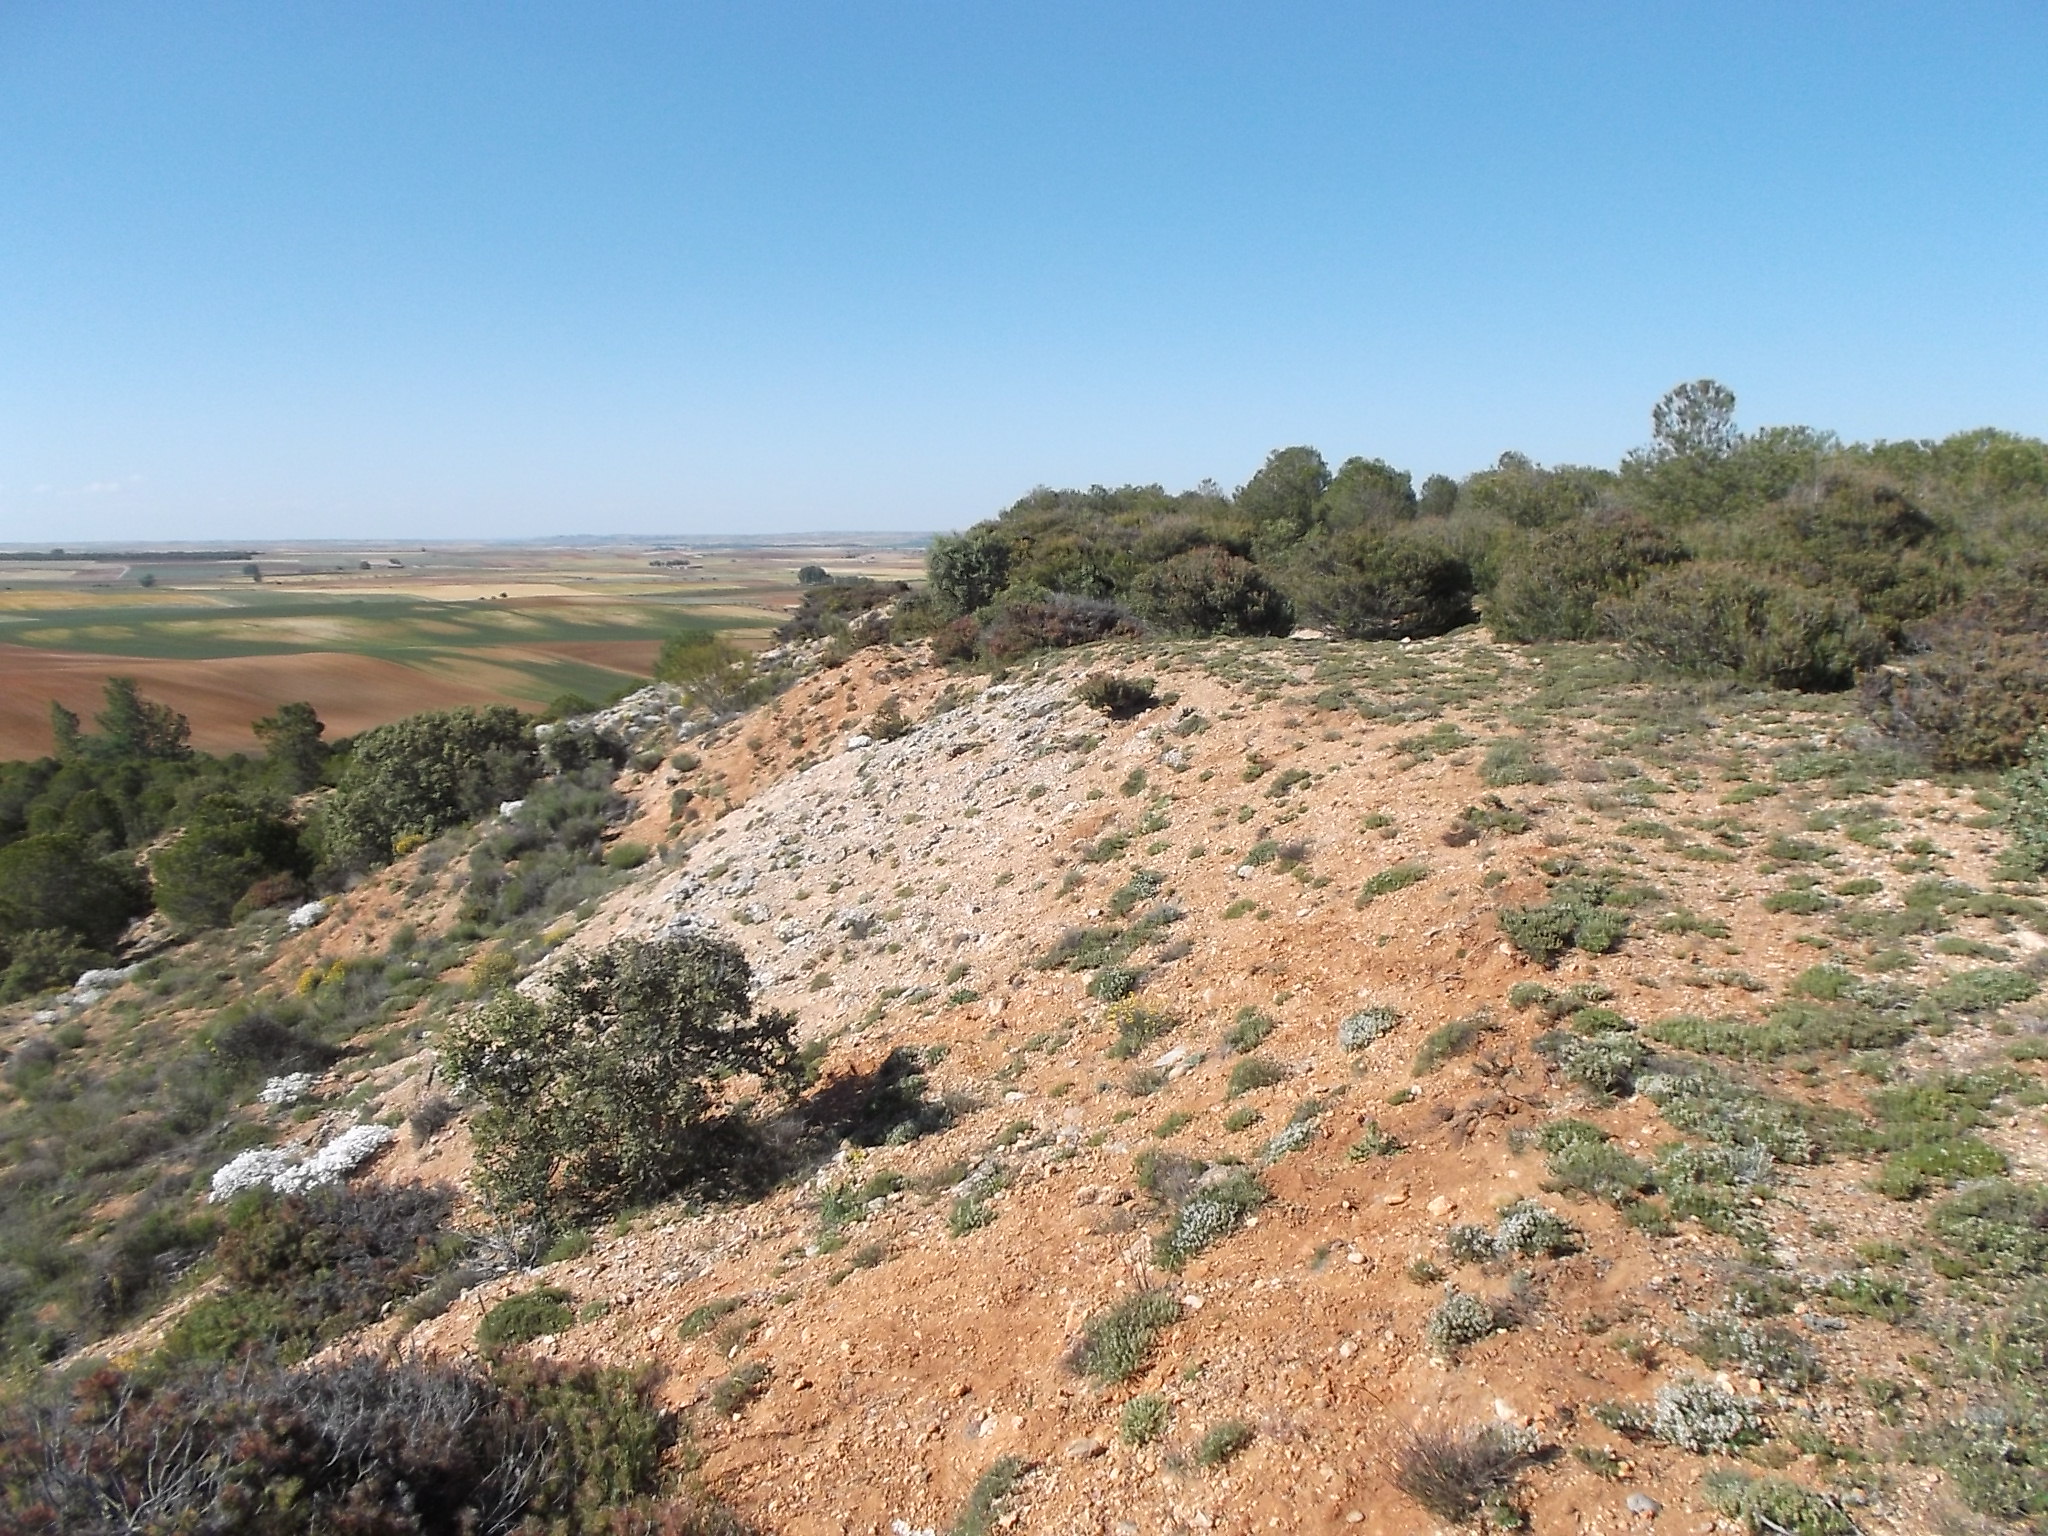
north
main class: Woodland
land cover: Pine dominated mixed woodland
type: coniferous forest of the mediterranean region
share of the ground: 25 - 50 %
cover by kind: herbaceous plants 35 %, coniferous forest trees 25 %, unconsolidated bare surface 20 %, broadleaved forest trees 10 %, shrubs 10 %
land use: Forestry
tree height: < 5 m
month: May
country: ES
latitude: 41.2109
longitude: -5.4013
